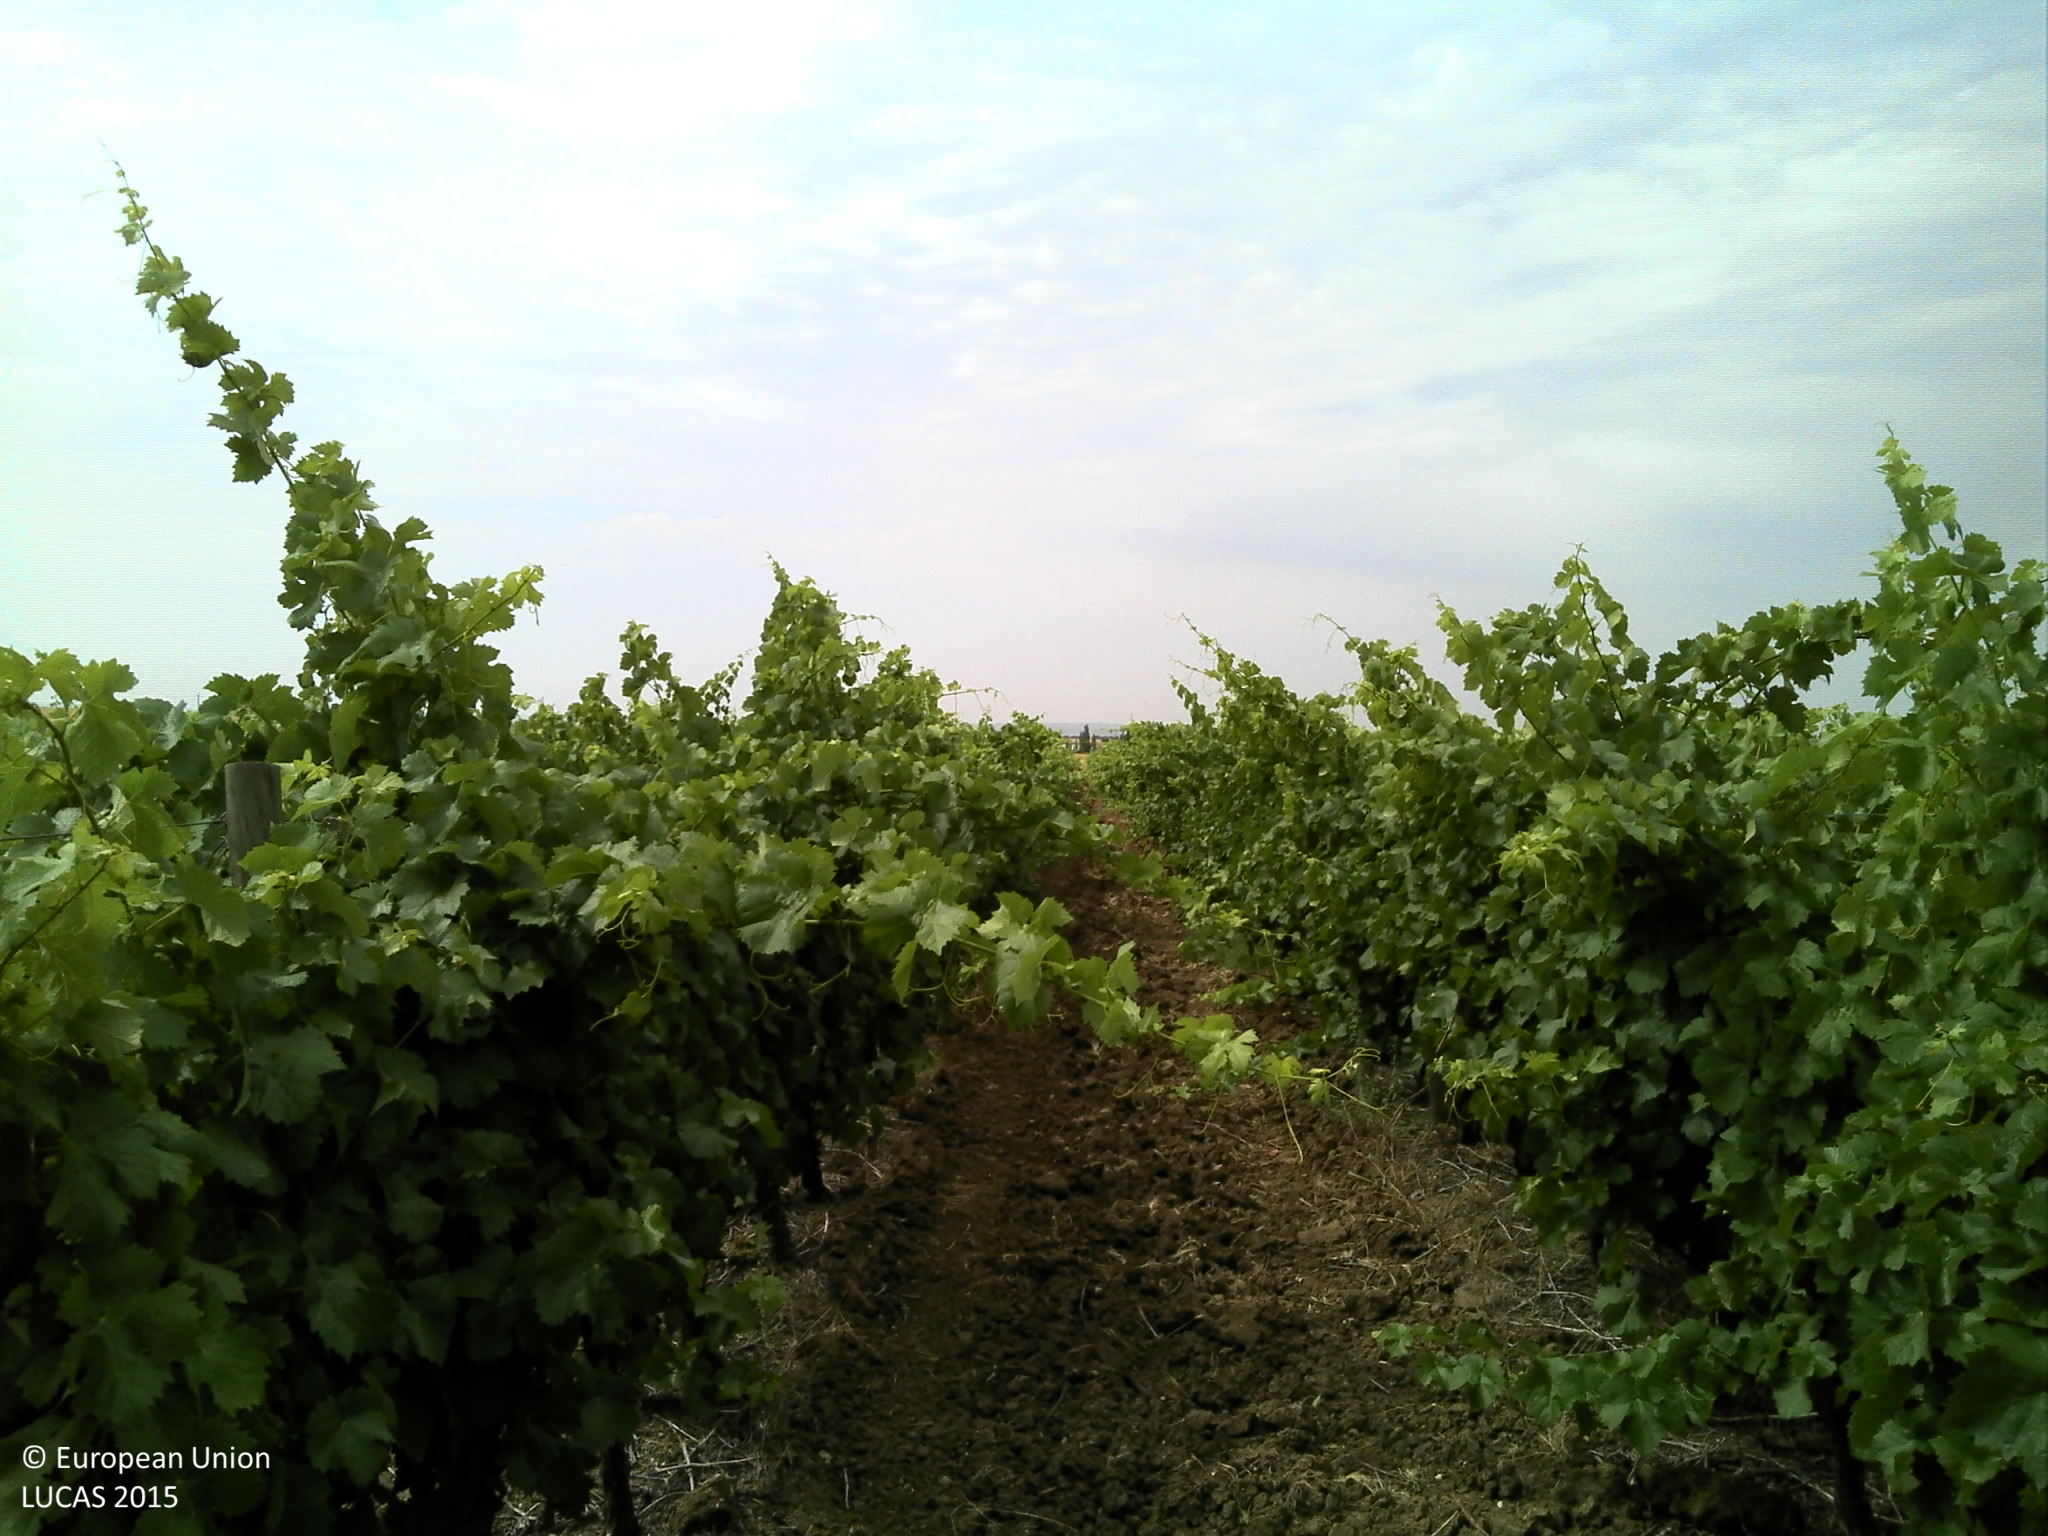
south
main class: Cropland
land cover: Vineyards
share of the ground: 25 - 50 %
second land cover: Other bare soil
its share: > 75 %
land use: Agriculture (excluding fallow land and kitchen gardens)
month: June
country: PT
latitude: 38.5447
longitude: -7.8325
